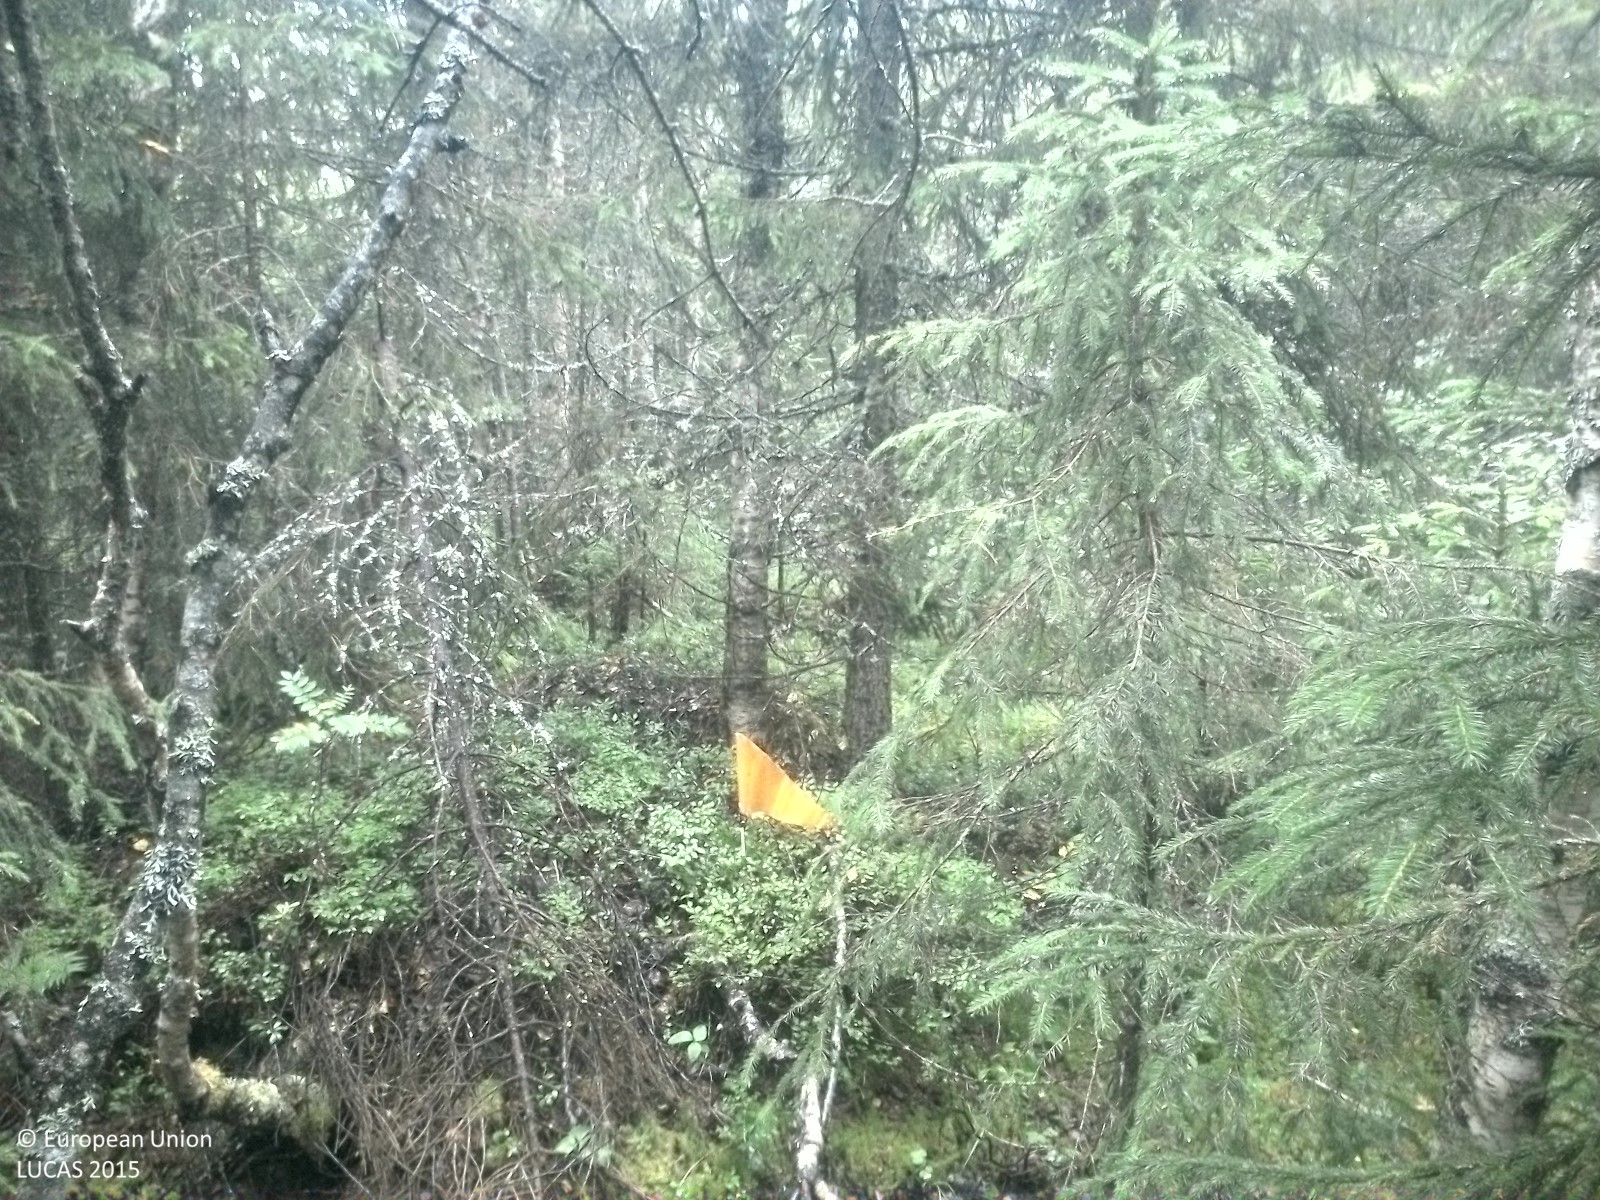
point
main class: Woodland
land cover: Spruce dominated mixed woodland
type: boreal forest
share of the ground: > 75 %
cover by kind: broadleaved forest trees 50 %, coniferous forest trees 35 %, shrubs 15 %
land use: Semi-natural and natural areas not in use
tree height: > 5 m
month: August
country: SE
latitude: 62.3002
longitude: 16.2859
